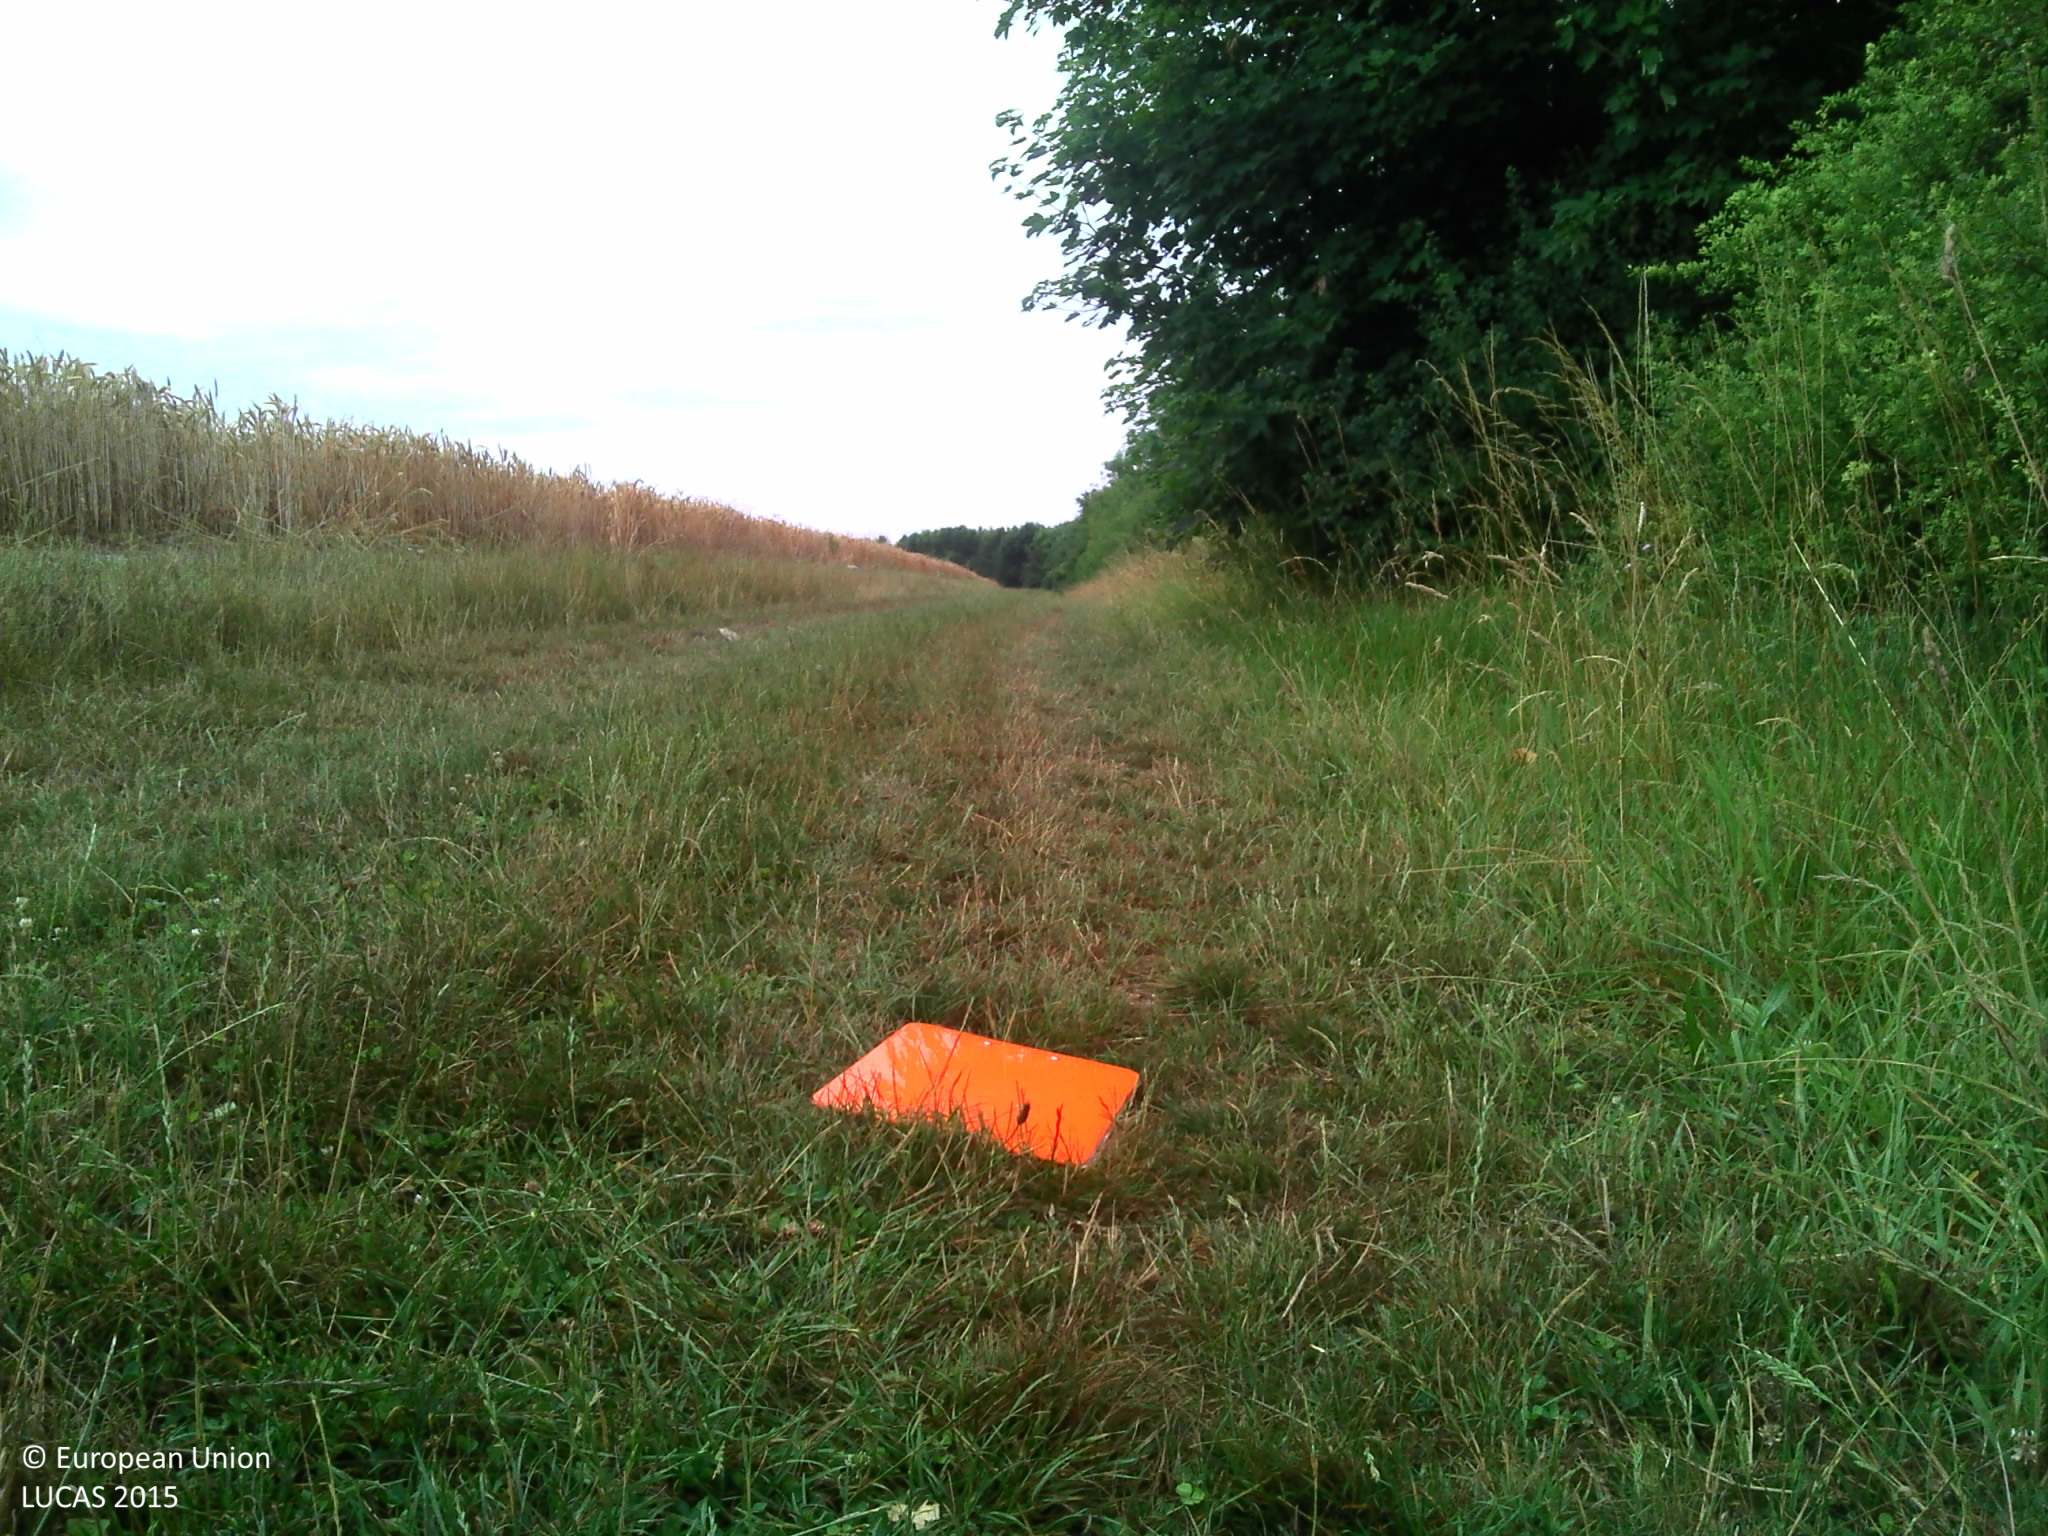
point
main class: Cropland
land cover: Common wheat
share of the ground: > 75 %
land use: Agriculture (excluding fallow land and kitchen gardens)
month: July
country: FR
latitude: 48.7543
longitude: 4.1607
